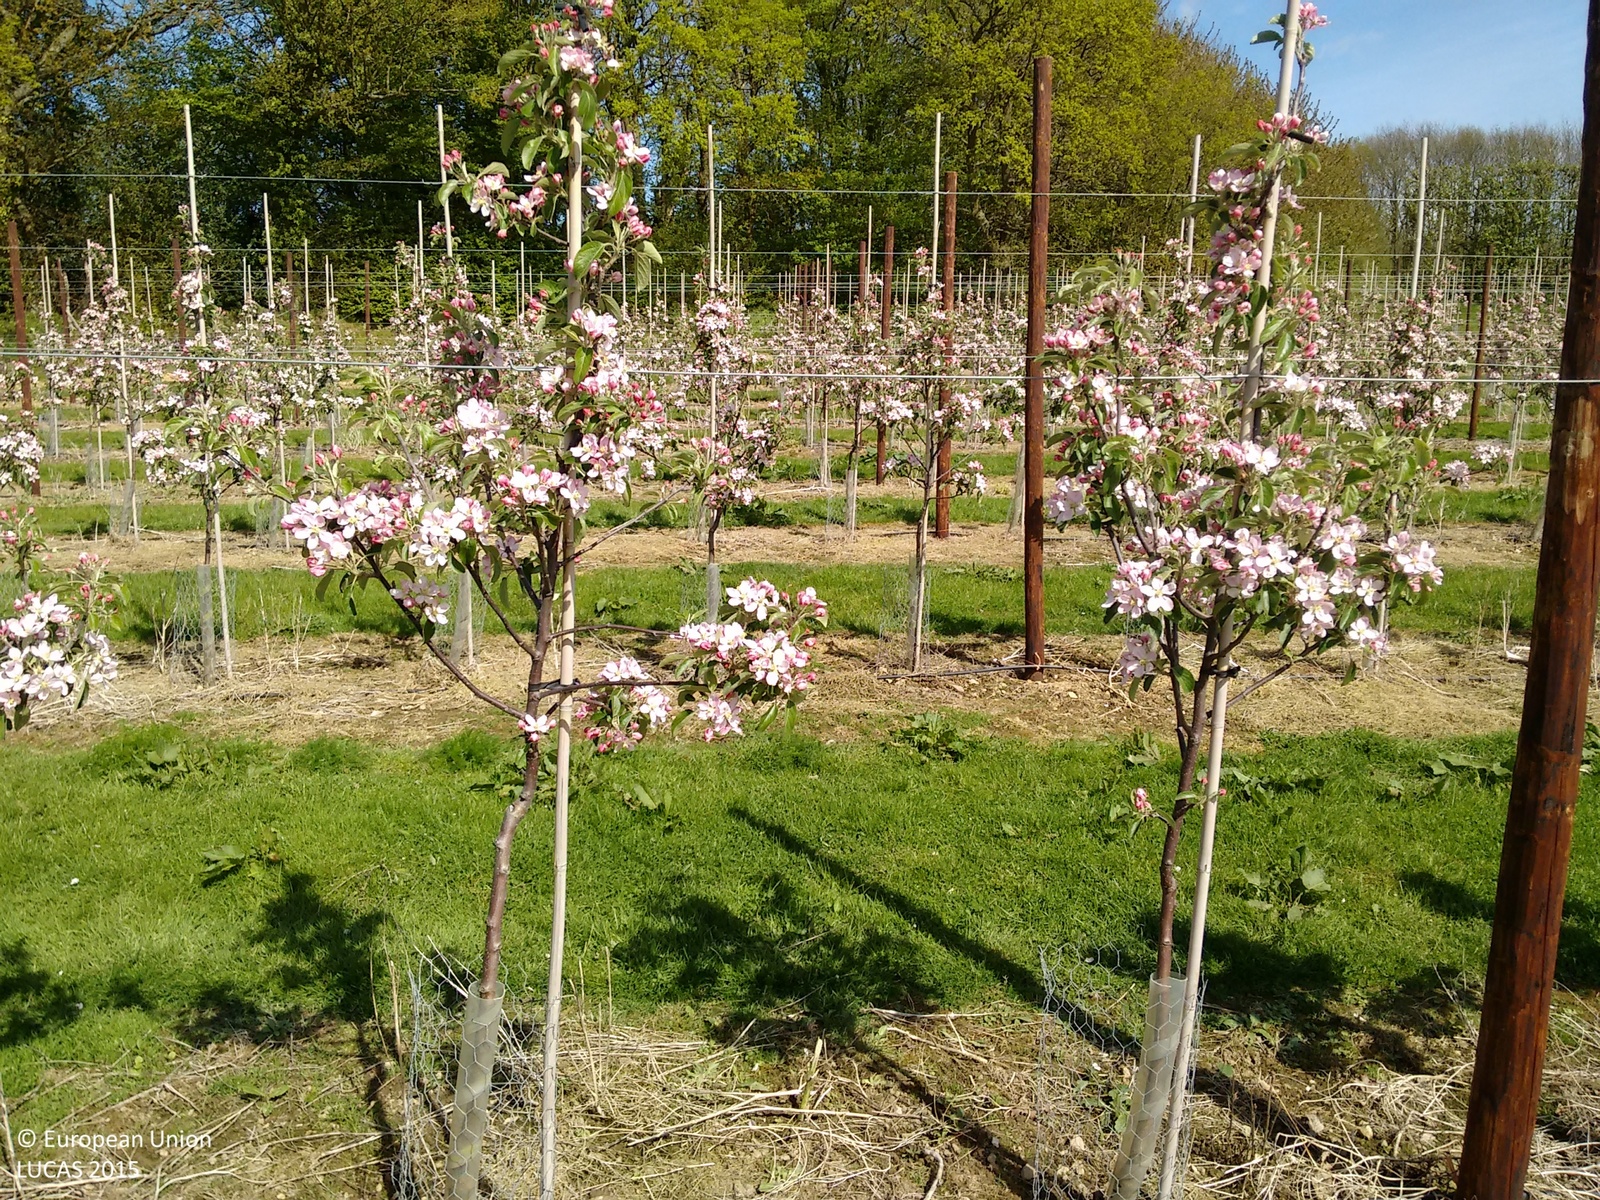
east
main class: Cropland
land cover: Apple fruit
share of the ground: 25 - 50 %
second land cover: Grassland without tree/shrub cover
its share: 50 - 75 %
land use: Agriculture (excluding fallow land and kitchen gardens)
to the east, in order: Apple fruit; Grassland without tree/shrub cover; Apple fruit; Broadleaved woodland; Fences; Tracks; Broadleaved woodland; Fences; Grassland without tree/shrub cover; Fences; Grass margins; Tracks
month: May
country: GB
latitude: 51.2572
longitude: 0.3269
